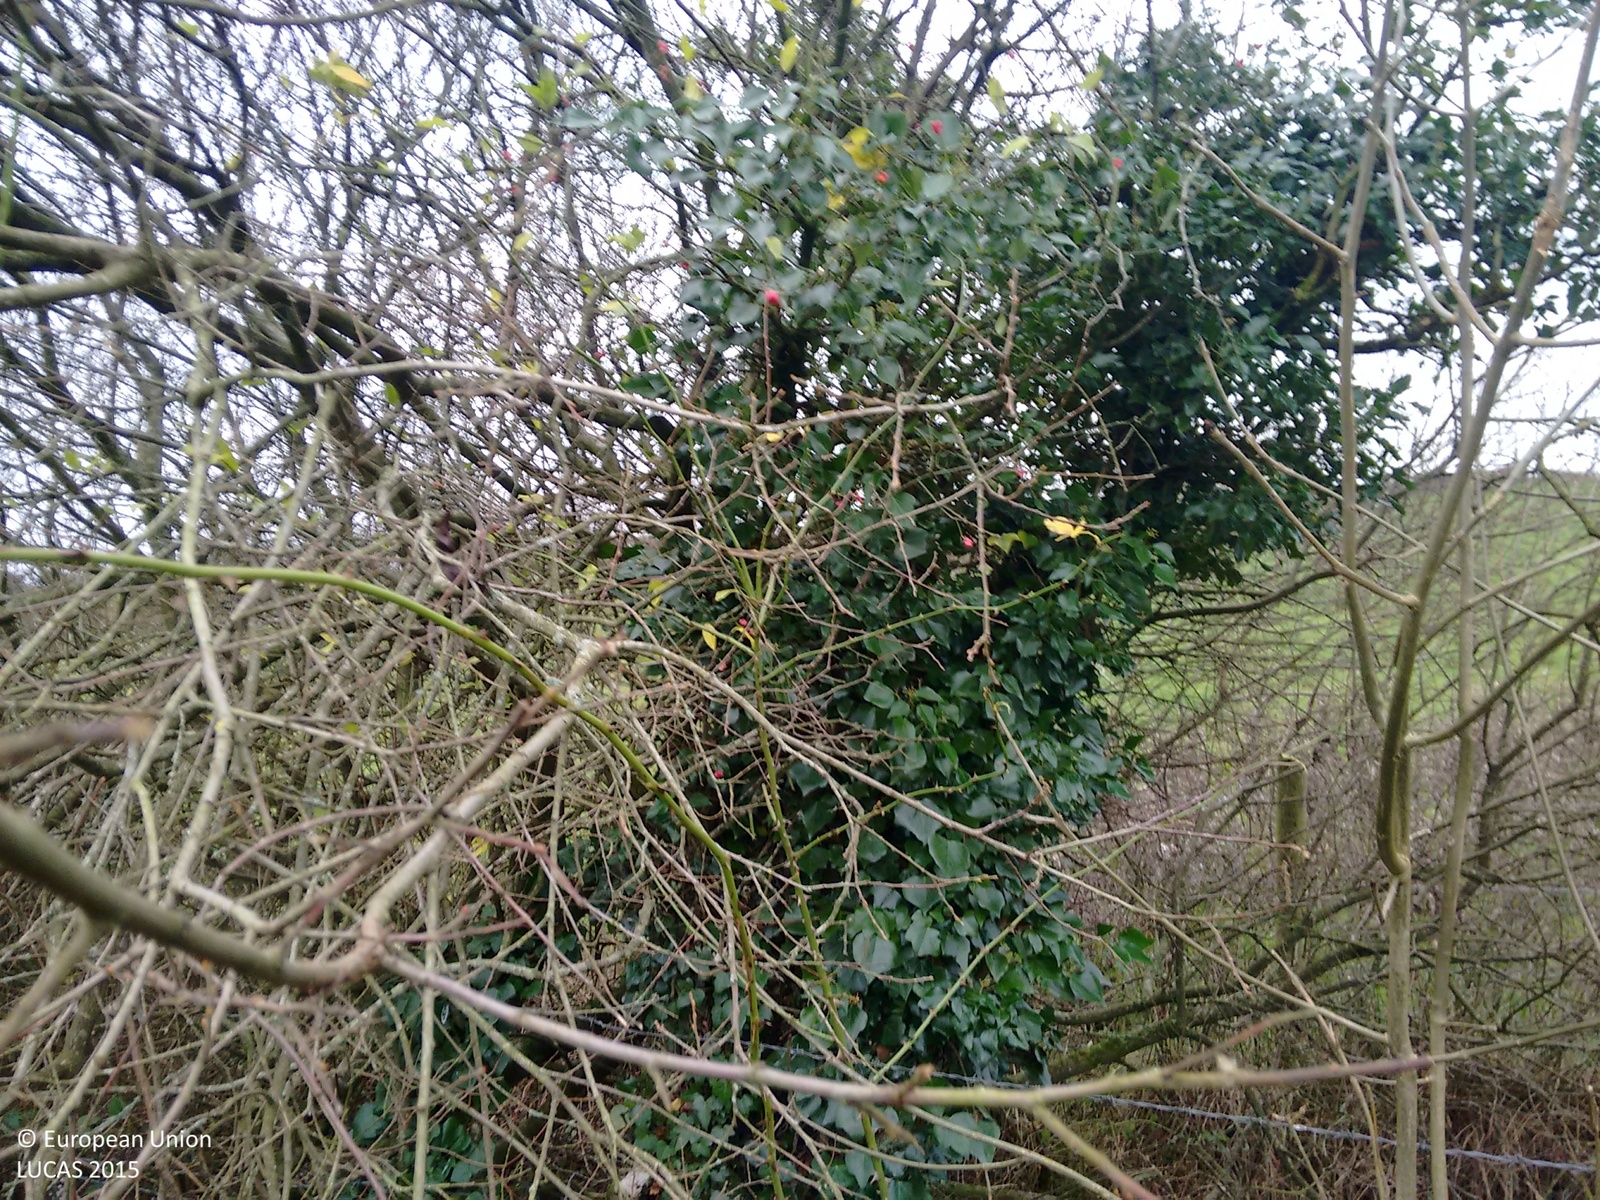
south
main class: Grassland
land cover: Grassland without tree/shrub cover
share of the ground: > 75 %
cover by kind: herbaceous plants 100 %
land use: Agriculture (excluding fallow land and kitchen gardens)
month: December
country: IE
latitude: 54.0529
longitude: -7.2096
